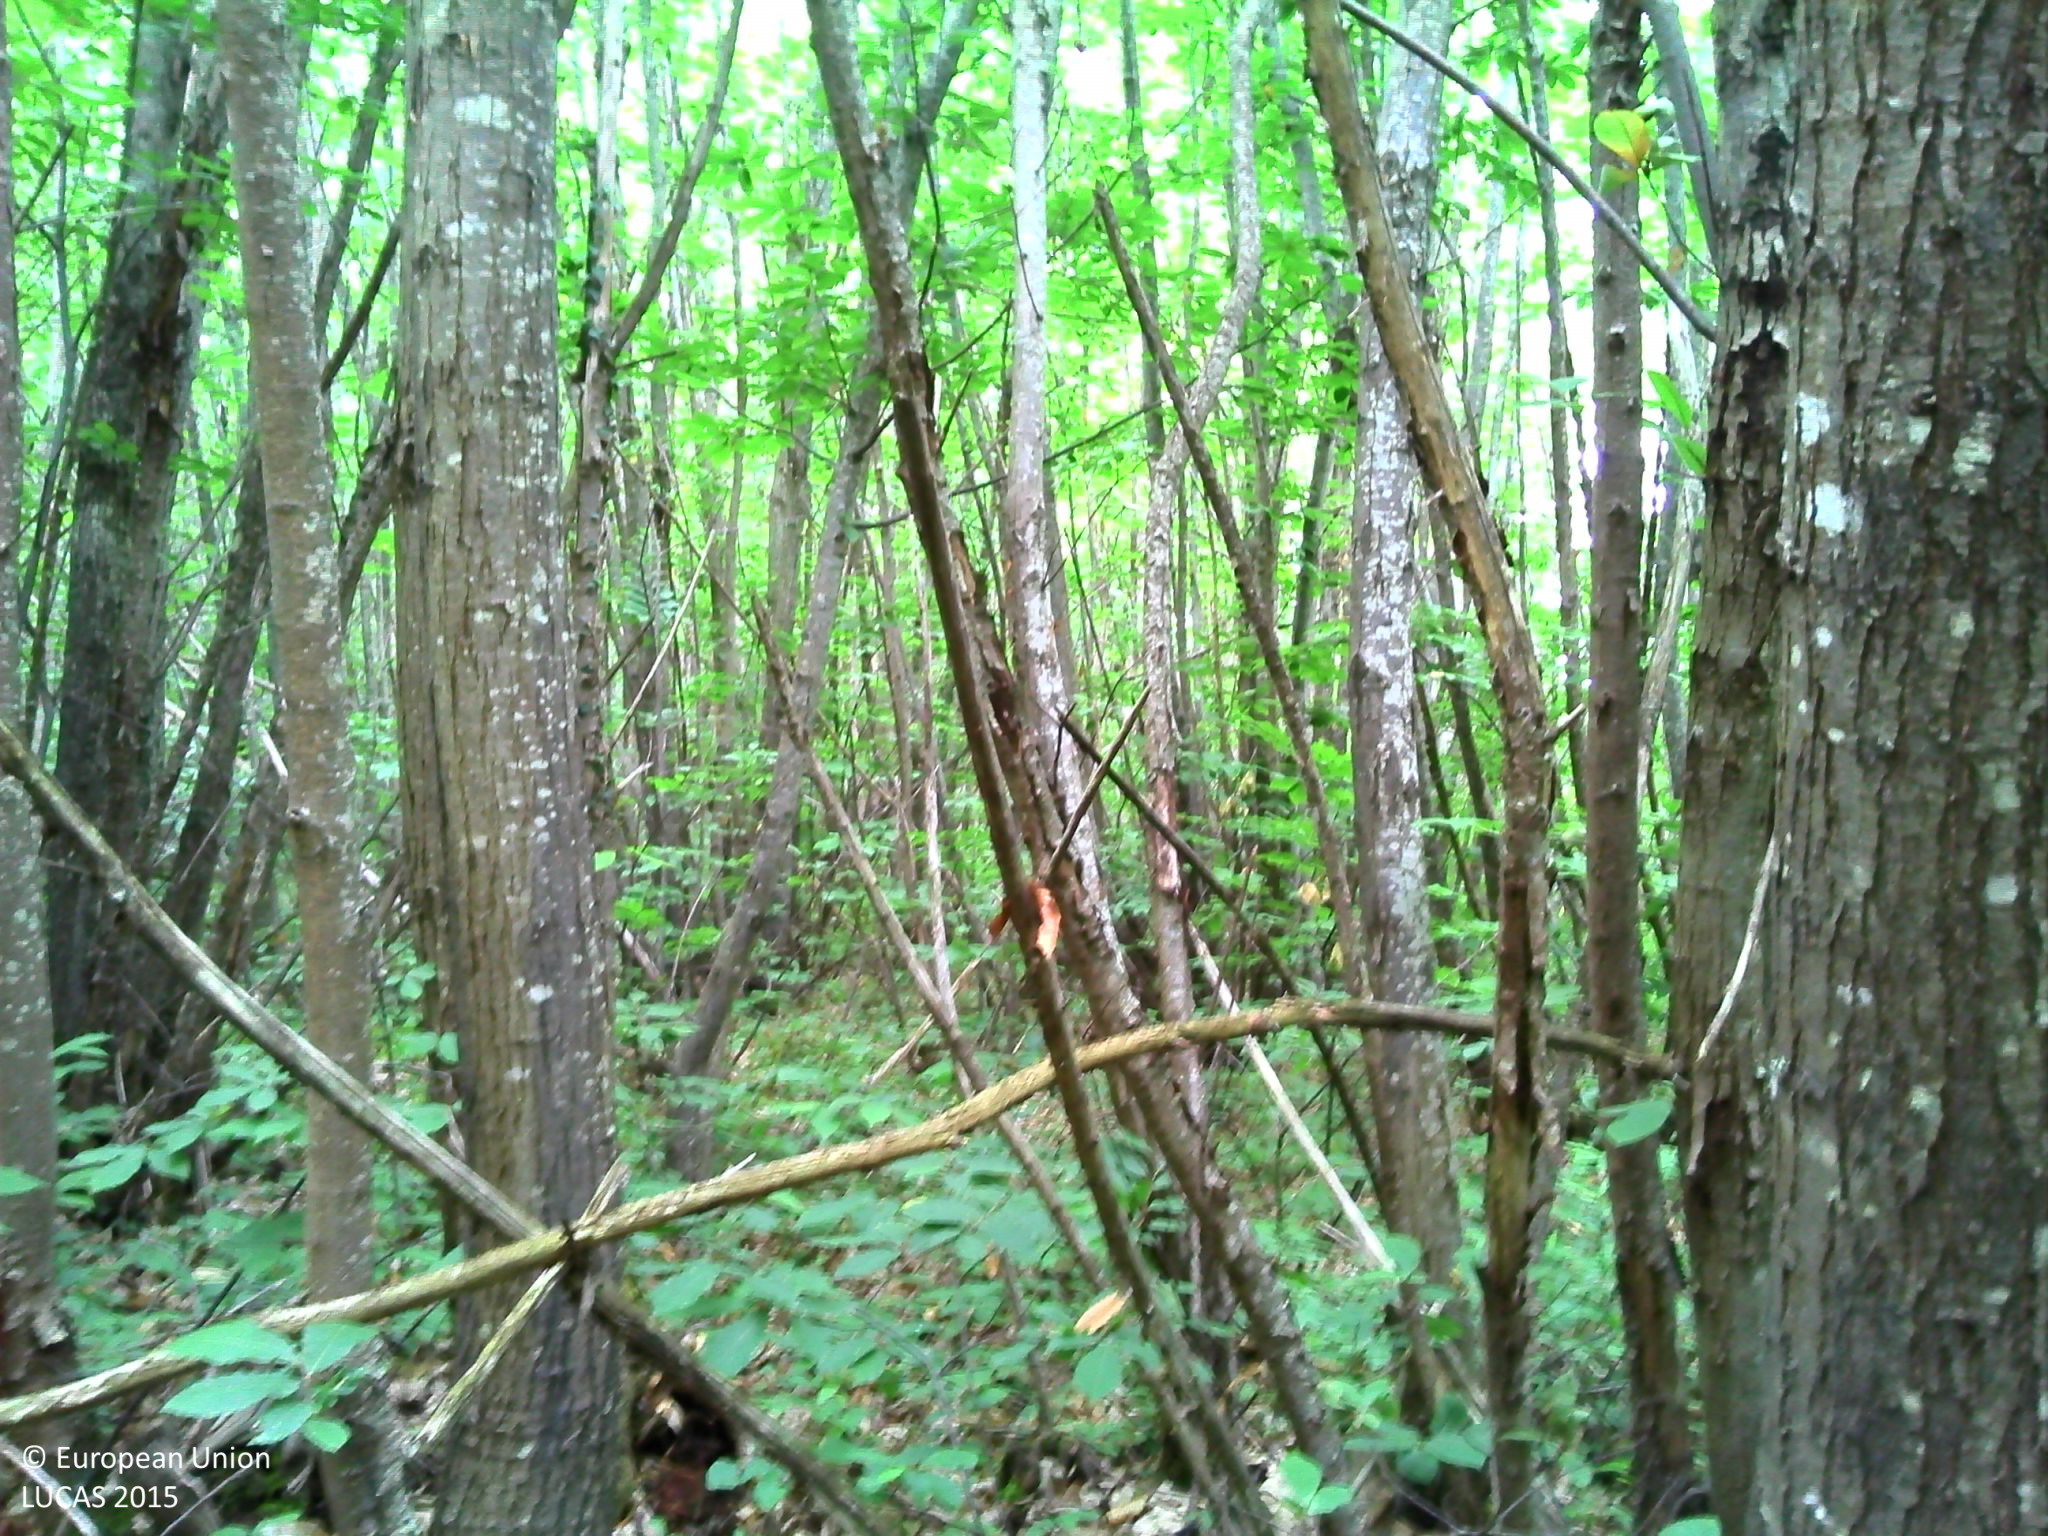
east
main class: Woodland
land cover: Broadleaved woodland
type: thermophilous deciduous forest
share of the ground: > 75 %
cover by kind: broadleaved forest trees 80 %, herbaceous plants 10 %, shrubs 5 %, lichens and mosses 5 %
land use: Forestry
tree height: > 5 m
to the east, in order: Broadleaved woodland
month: August
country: FR
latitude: 44.6998
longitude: 0.9708
